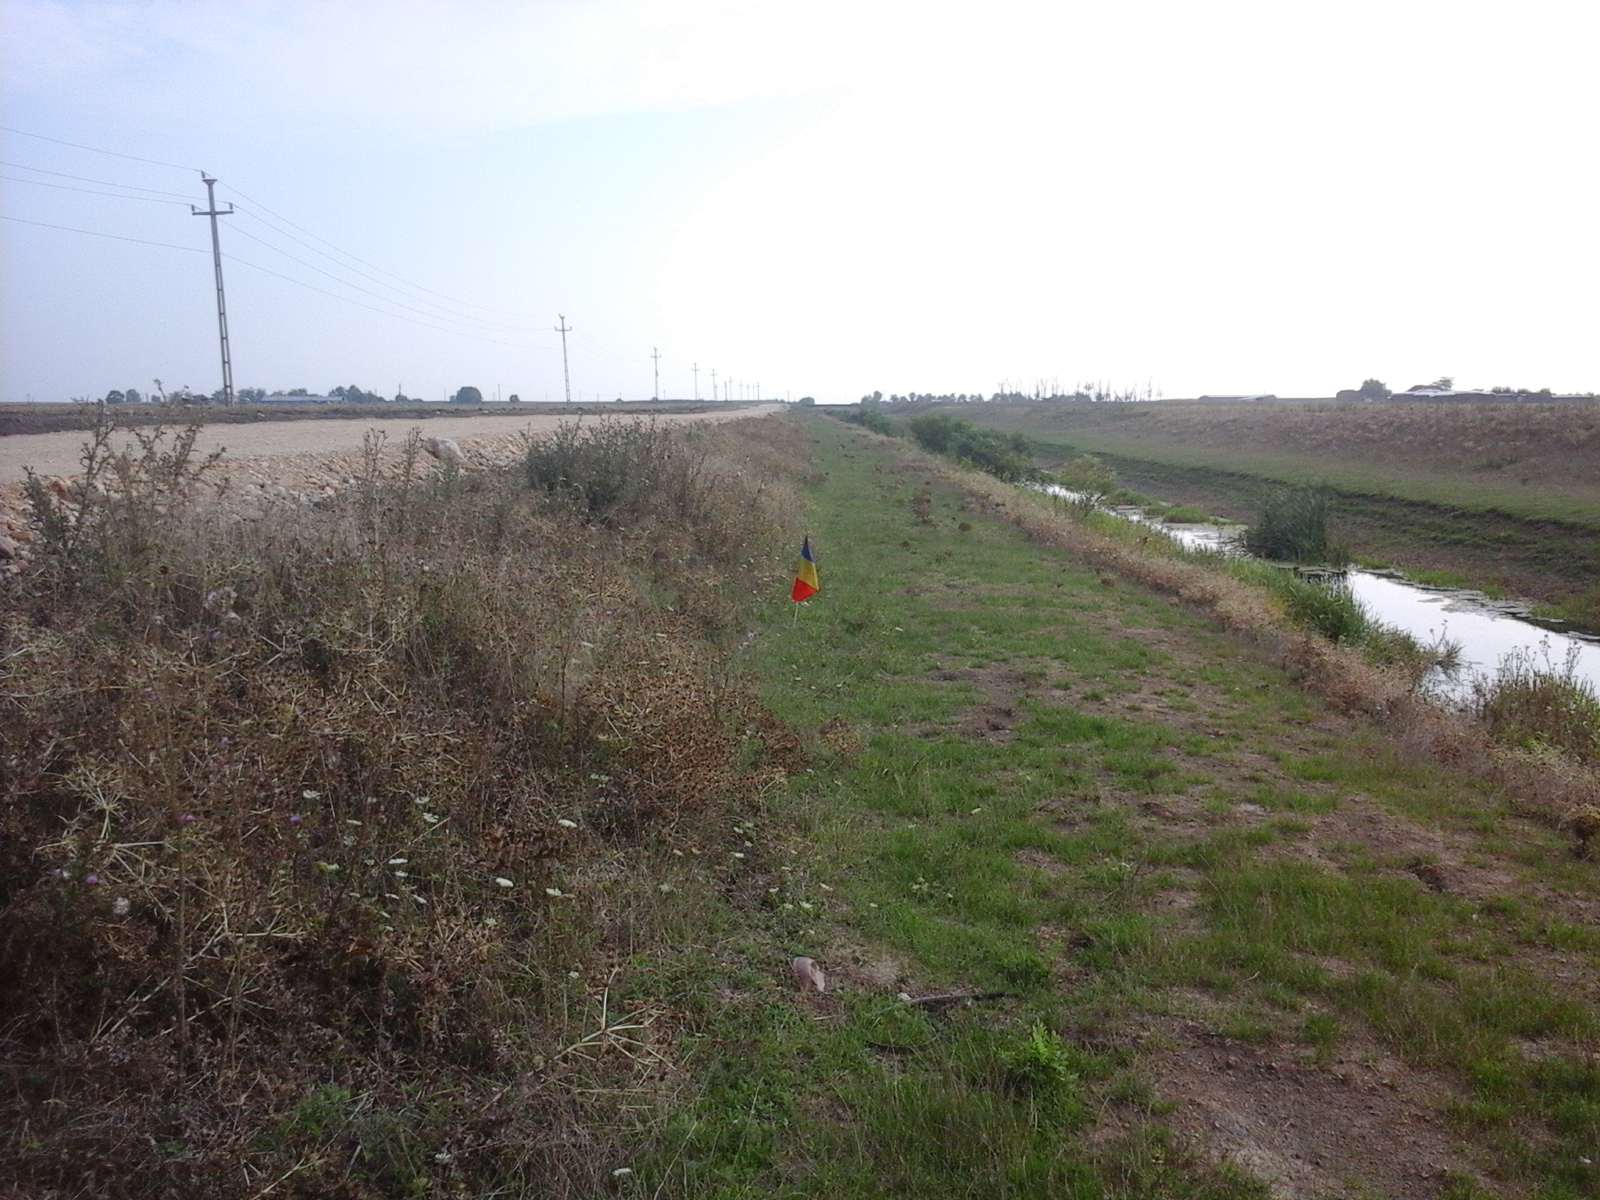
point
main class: Grassland
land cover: Grassland without tree/shrub cover
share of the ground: > 75 %
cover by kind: herbaceous plants 100 %
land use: Agriculture (excluding fallow land and kitchen gardens)
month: August
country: RO
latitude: 46.7067
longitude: 21.5365
